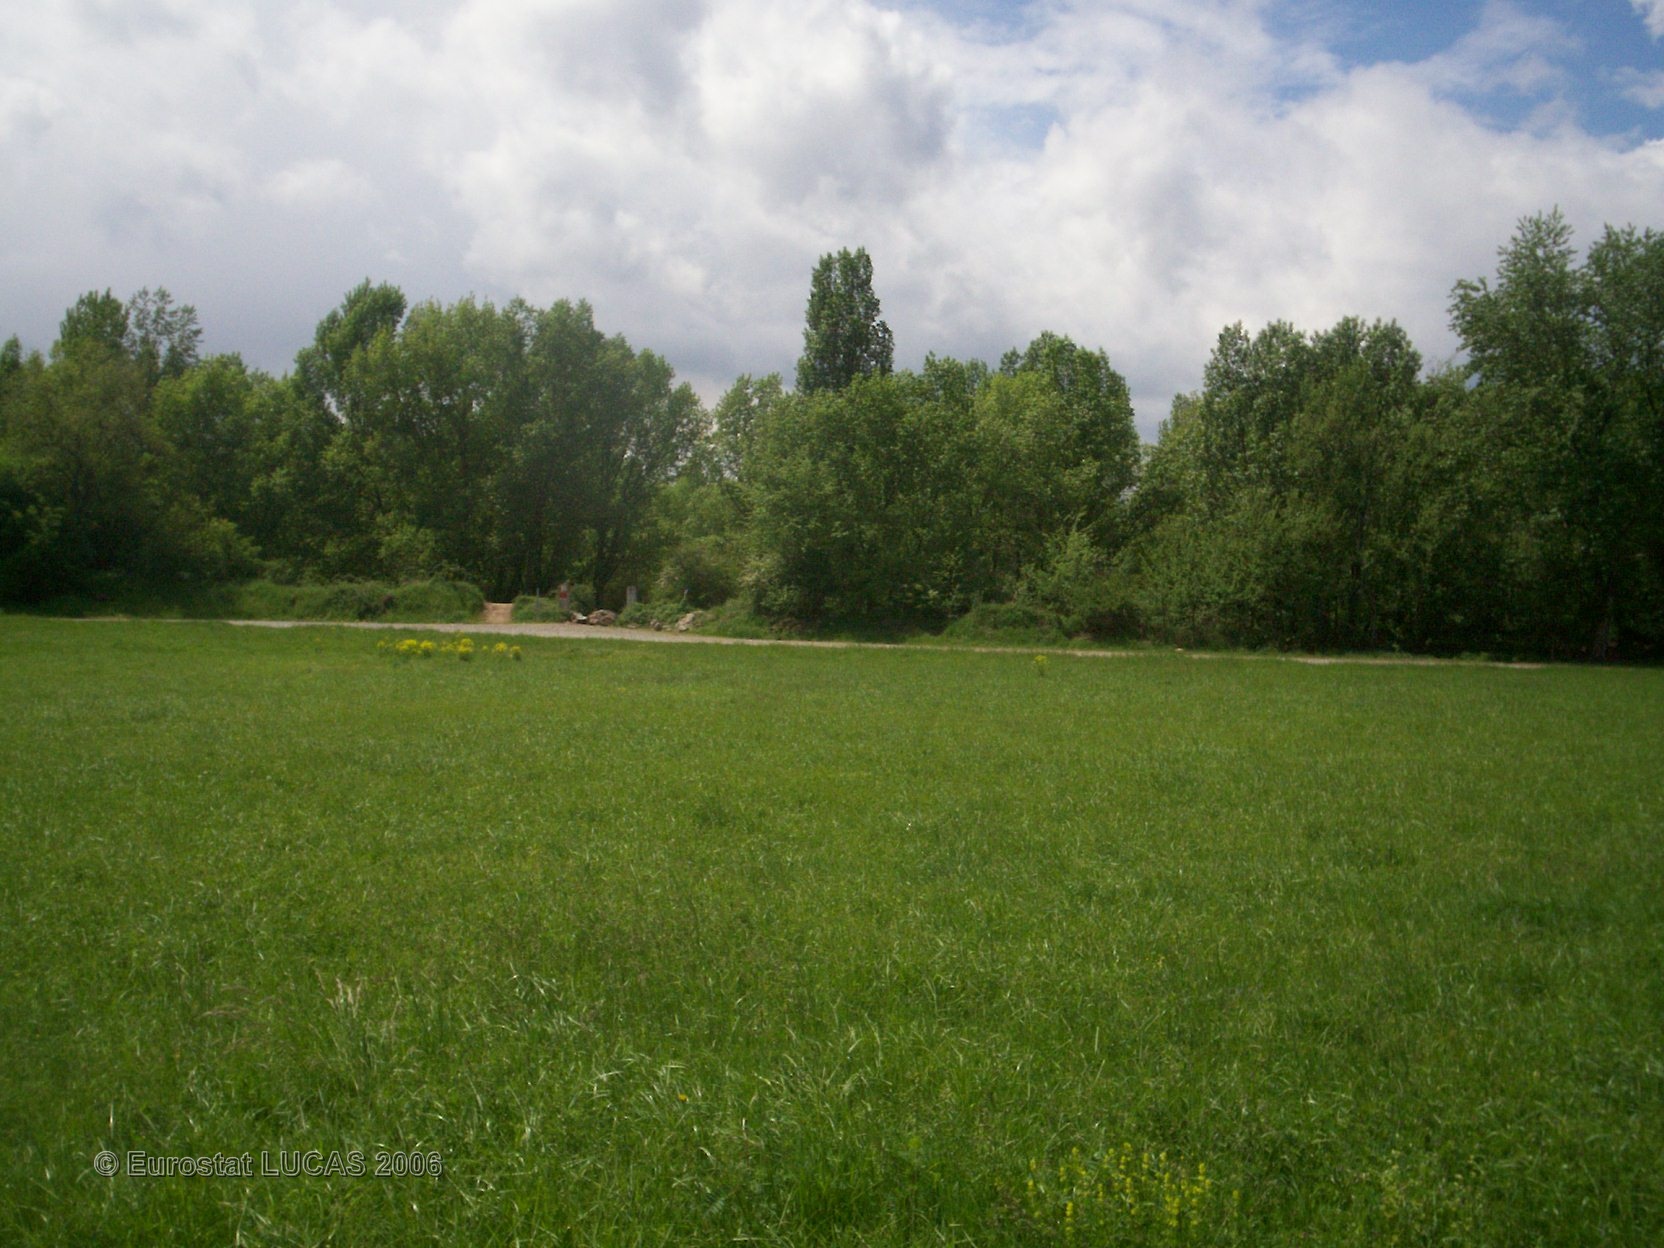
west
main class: Grassland
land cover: Grassland without tree/shrub cover
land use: Agriculture (excluding fallow land and kitchen gardens)
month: May
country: FR
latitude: 45.6834
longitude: 3.2084
